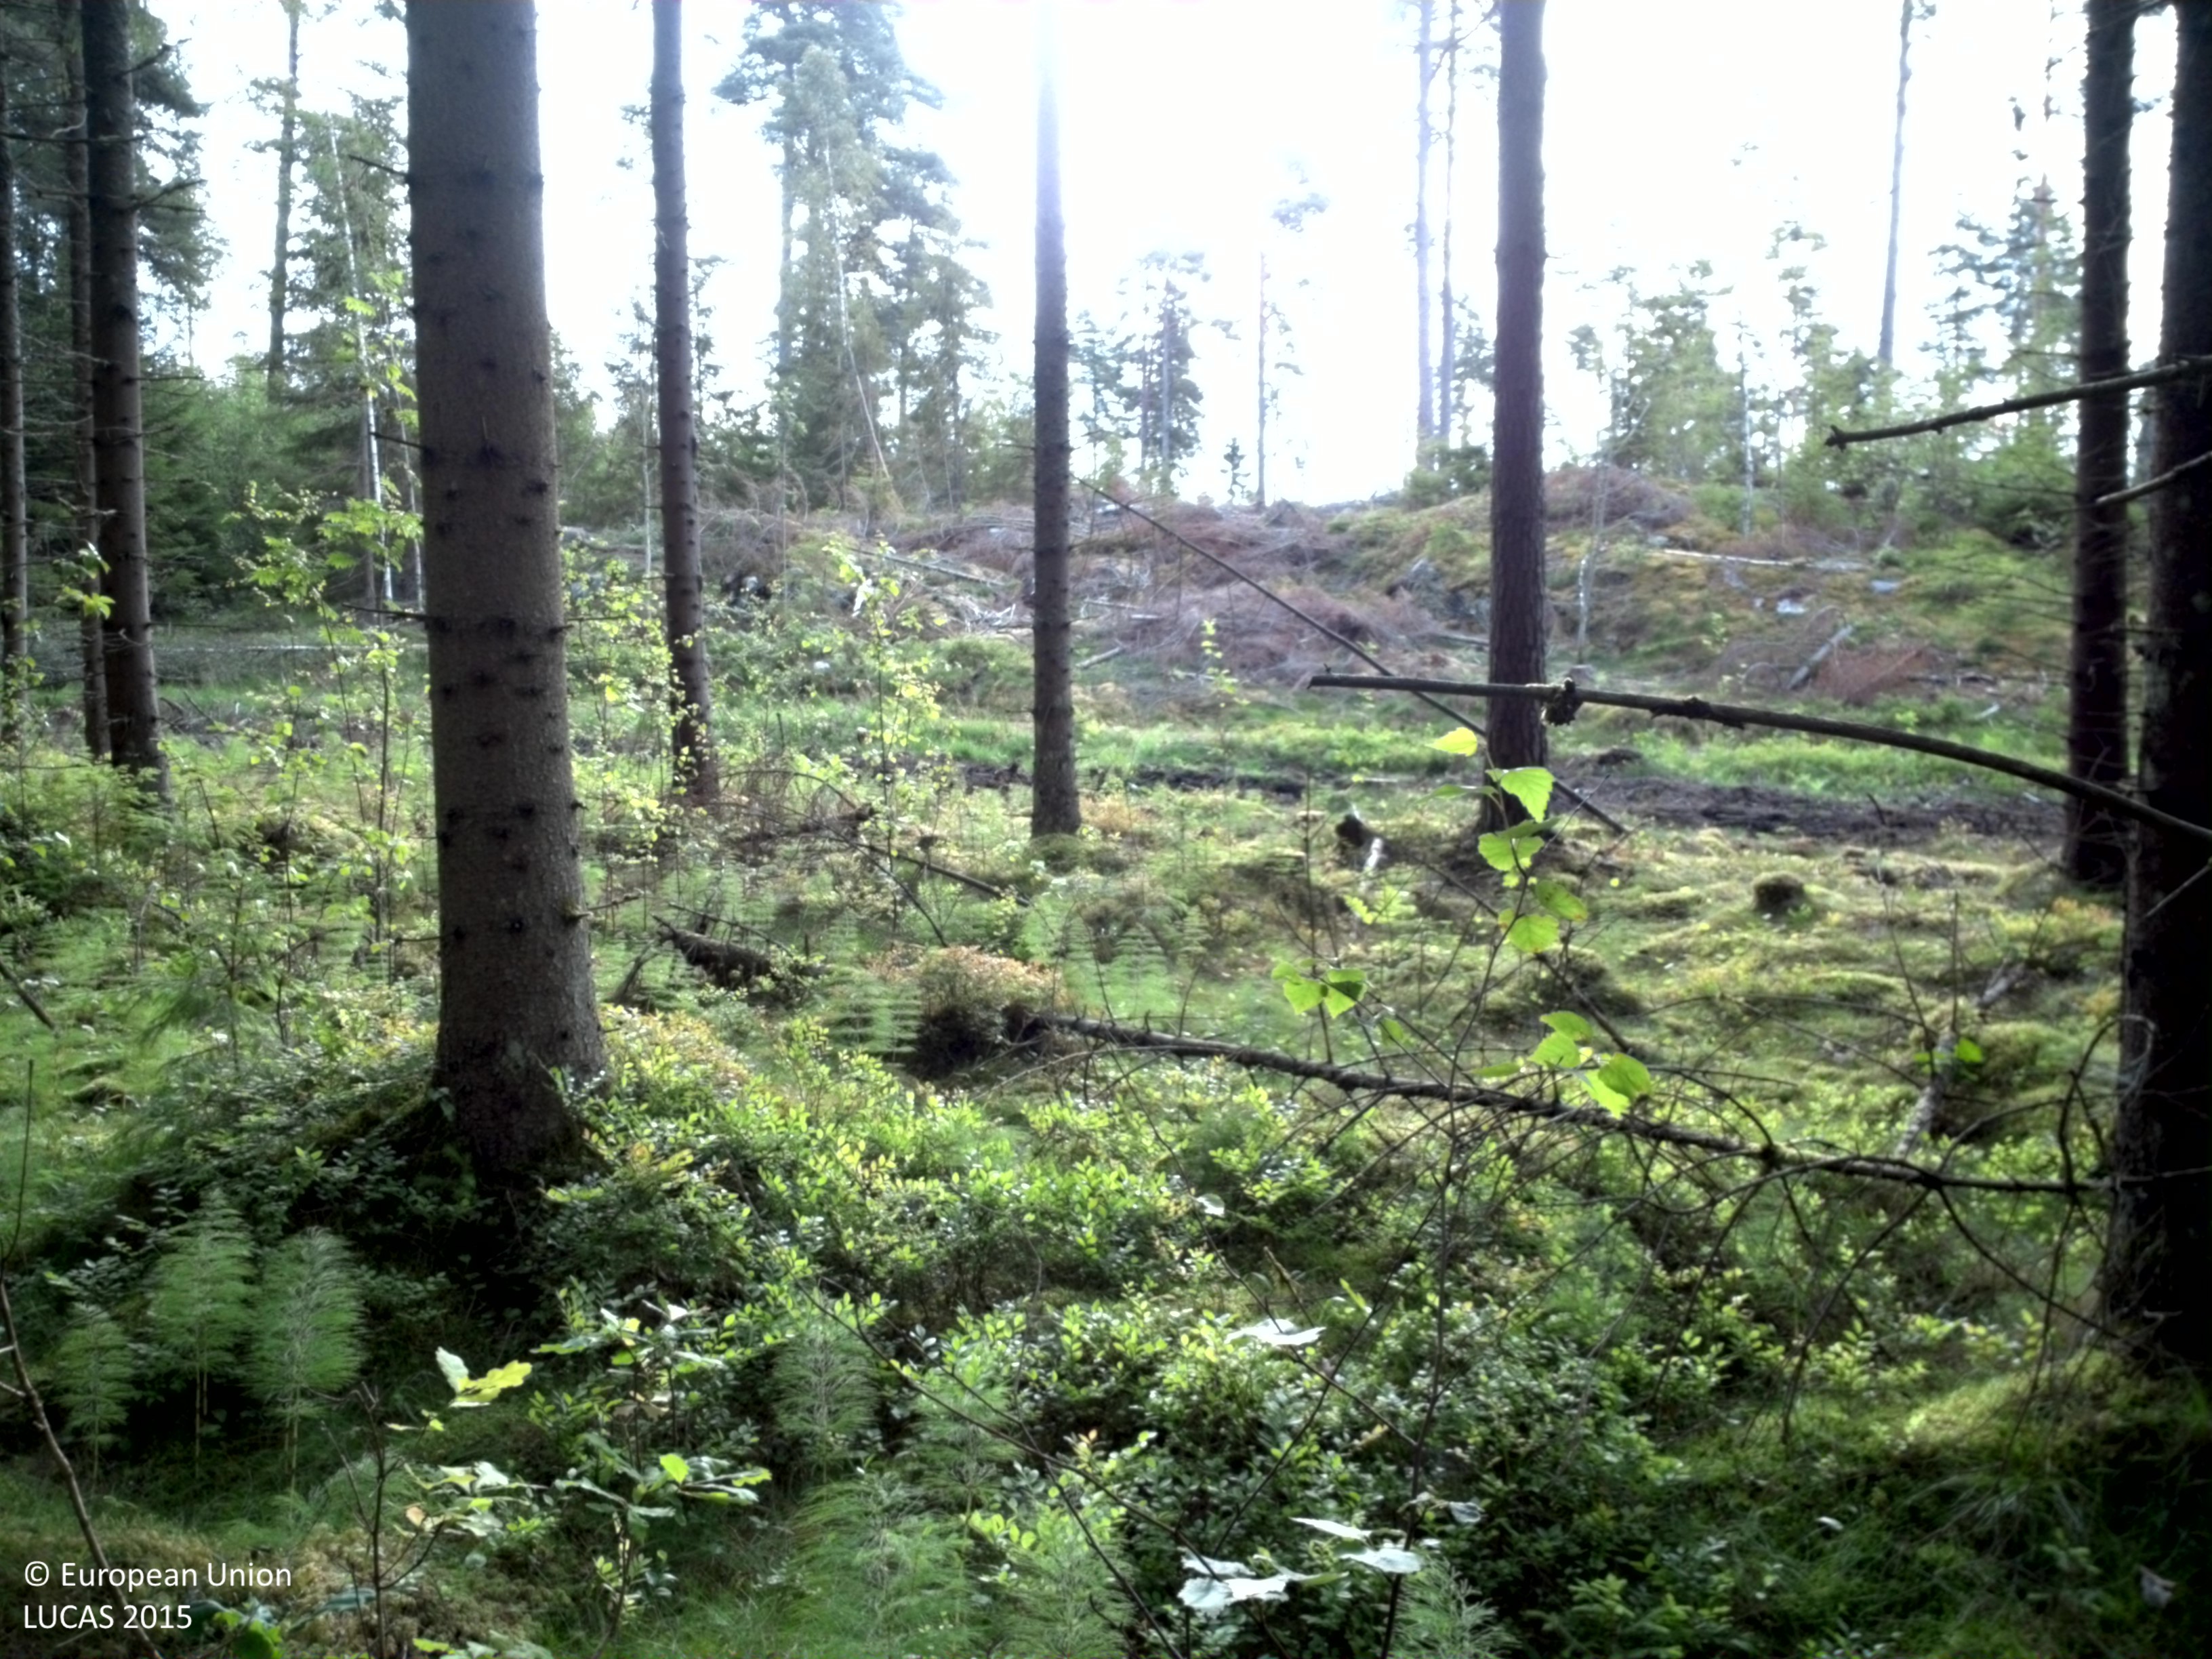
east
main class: Woodland
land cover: Spruce dominated coniferous woodland
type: boreal forest
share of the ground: 25 - 50 %
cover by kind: coniferous forest trees 40 %, lichens and mosses 30 %, herbaceous plants 25 %, broadleaved forest trees 5 %
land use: Forestry
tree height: > 5 m
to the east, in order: Spruce dominated coniferous woodland; Paved roads, cycling and walking lanes; Spruce dominated mixed woodland; Other mixed woodland; Spruce dominated mixed woodland; Broadleaved woodland; Spruce dominated mixed woodland
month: July
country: SE
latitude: 58.9064
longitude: 14.8708
